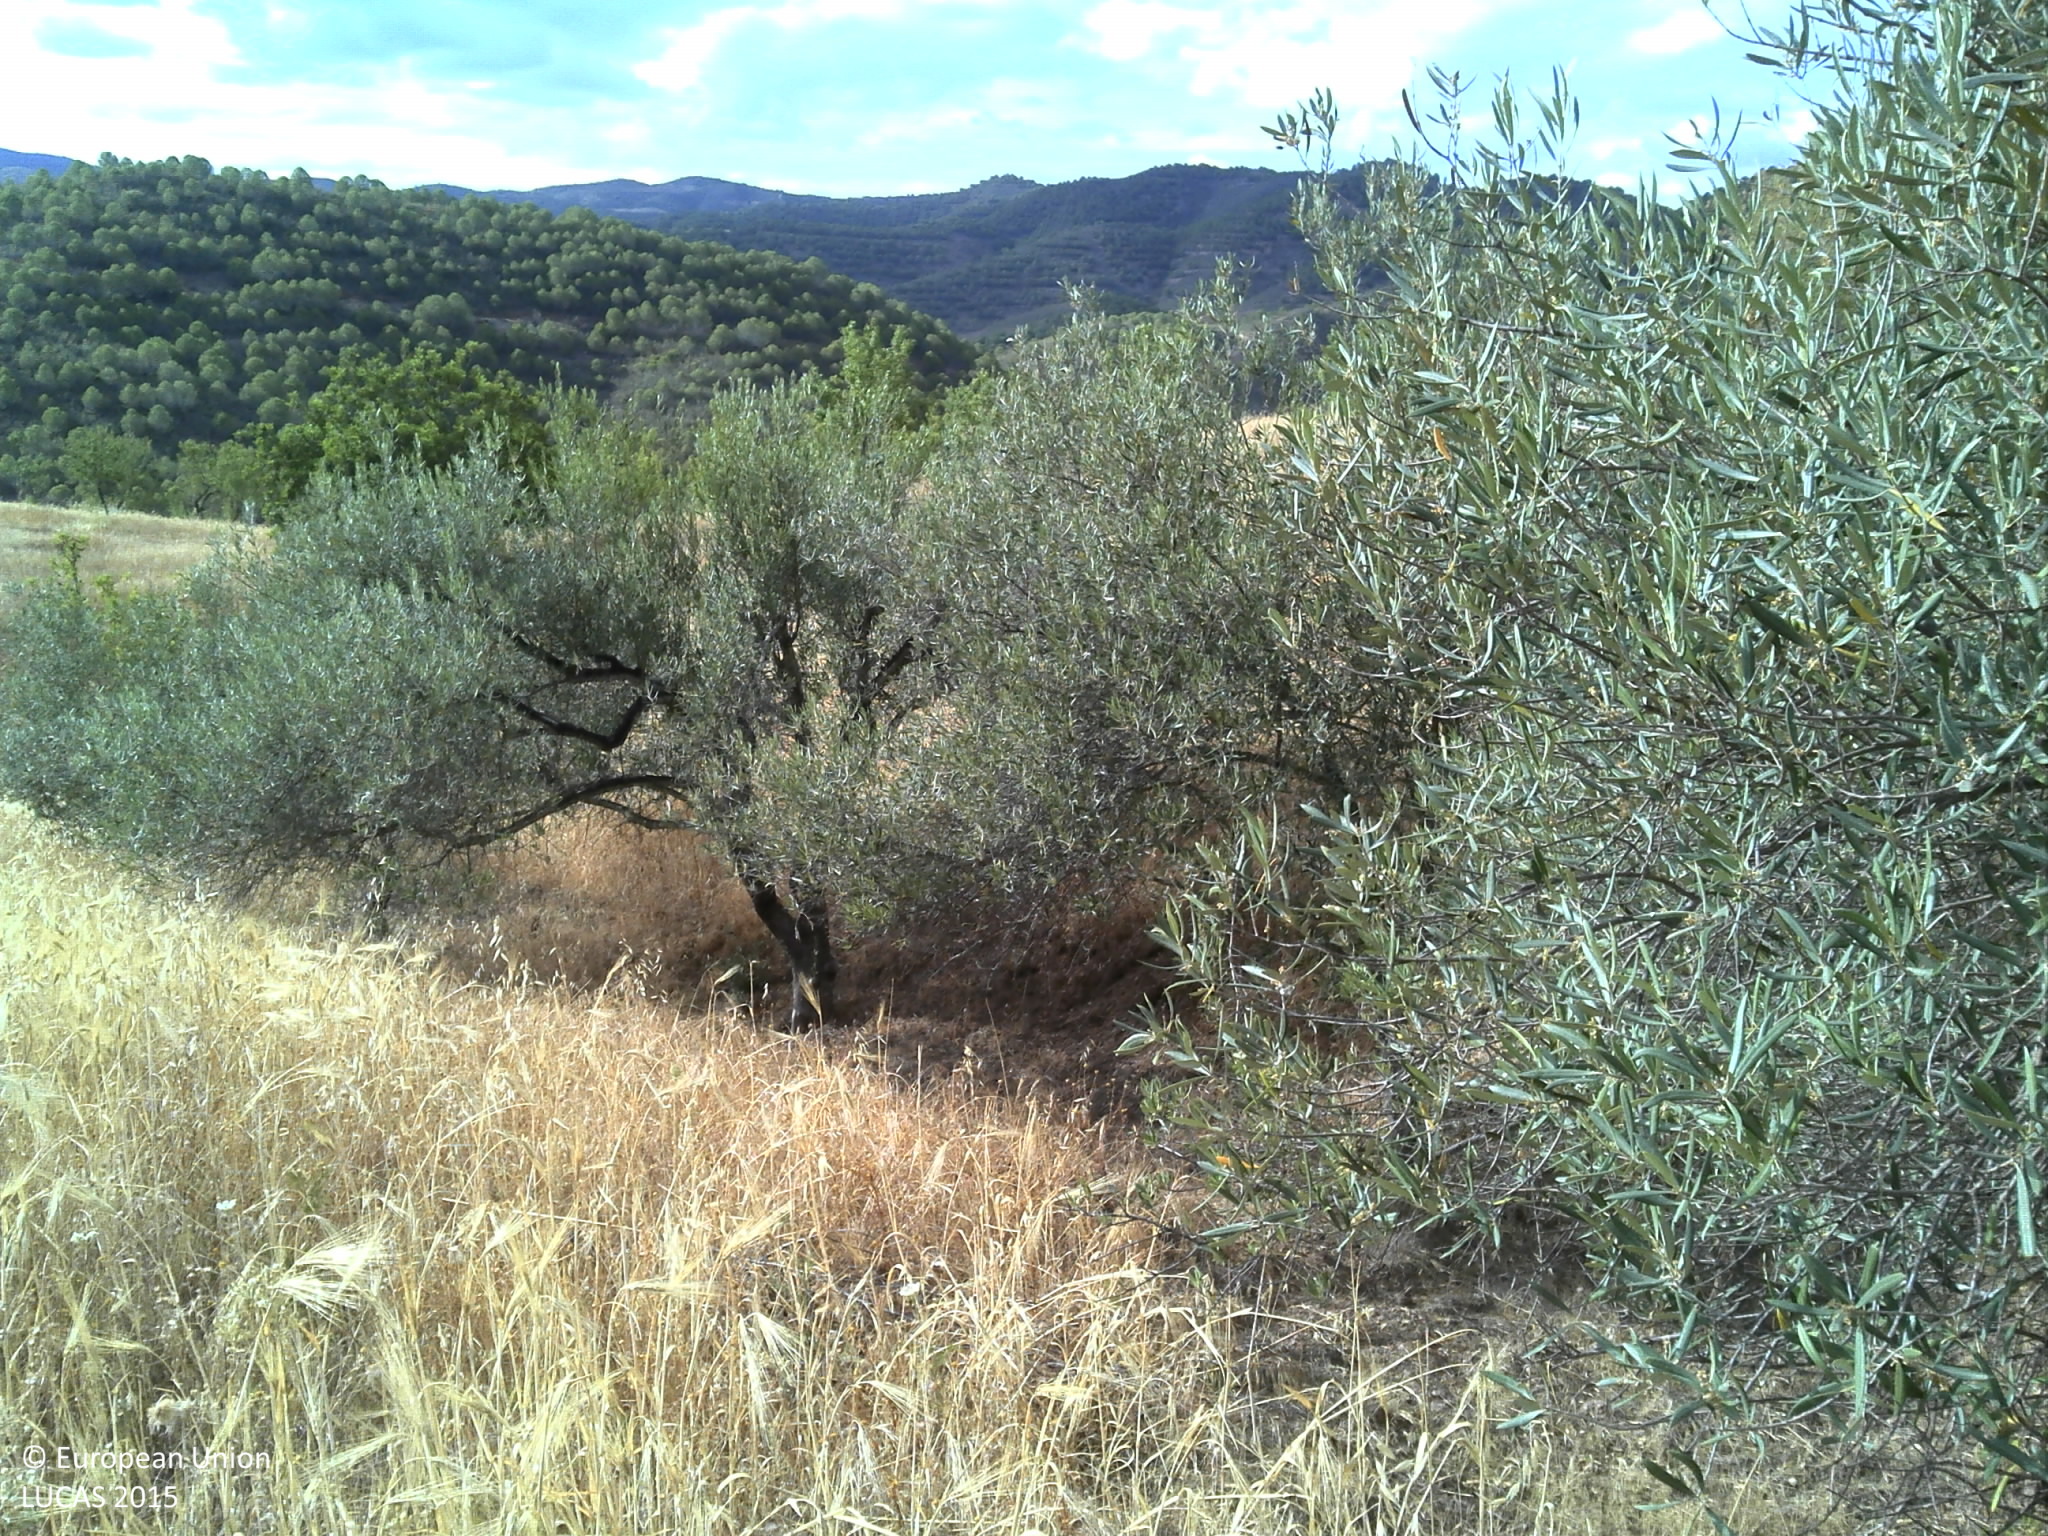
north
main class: Cropland
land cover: Nuts trees
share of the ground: 25 - 50 %
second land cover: Barley
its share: > 75 %
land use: Agriculture (excluding fallow land and kitchen gardens)
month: June
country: PT
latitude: 37.3277
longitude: -7.7176
